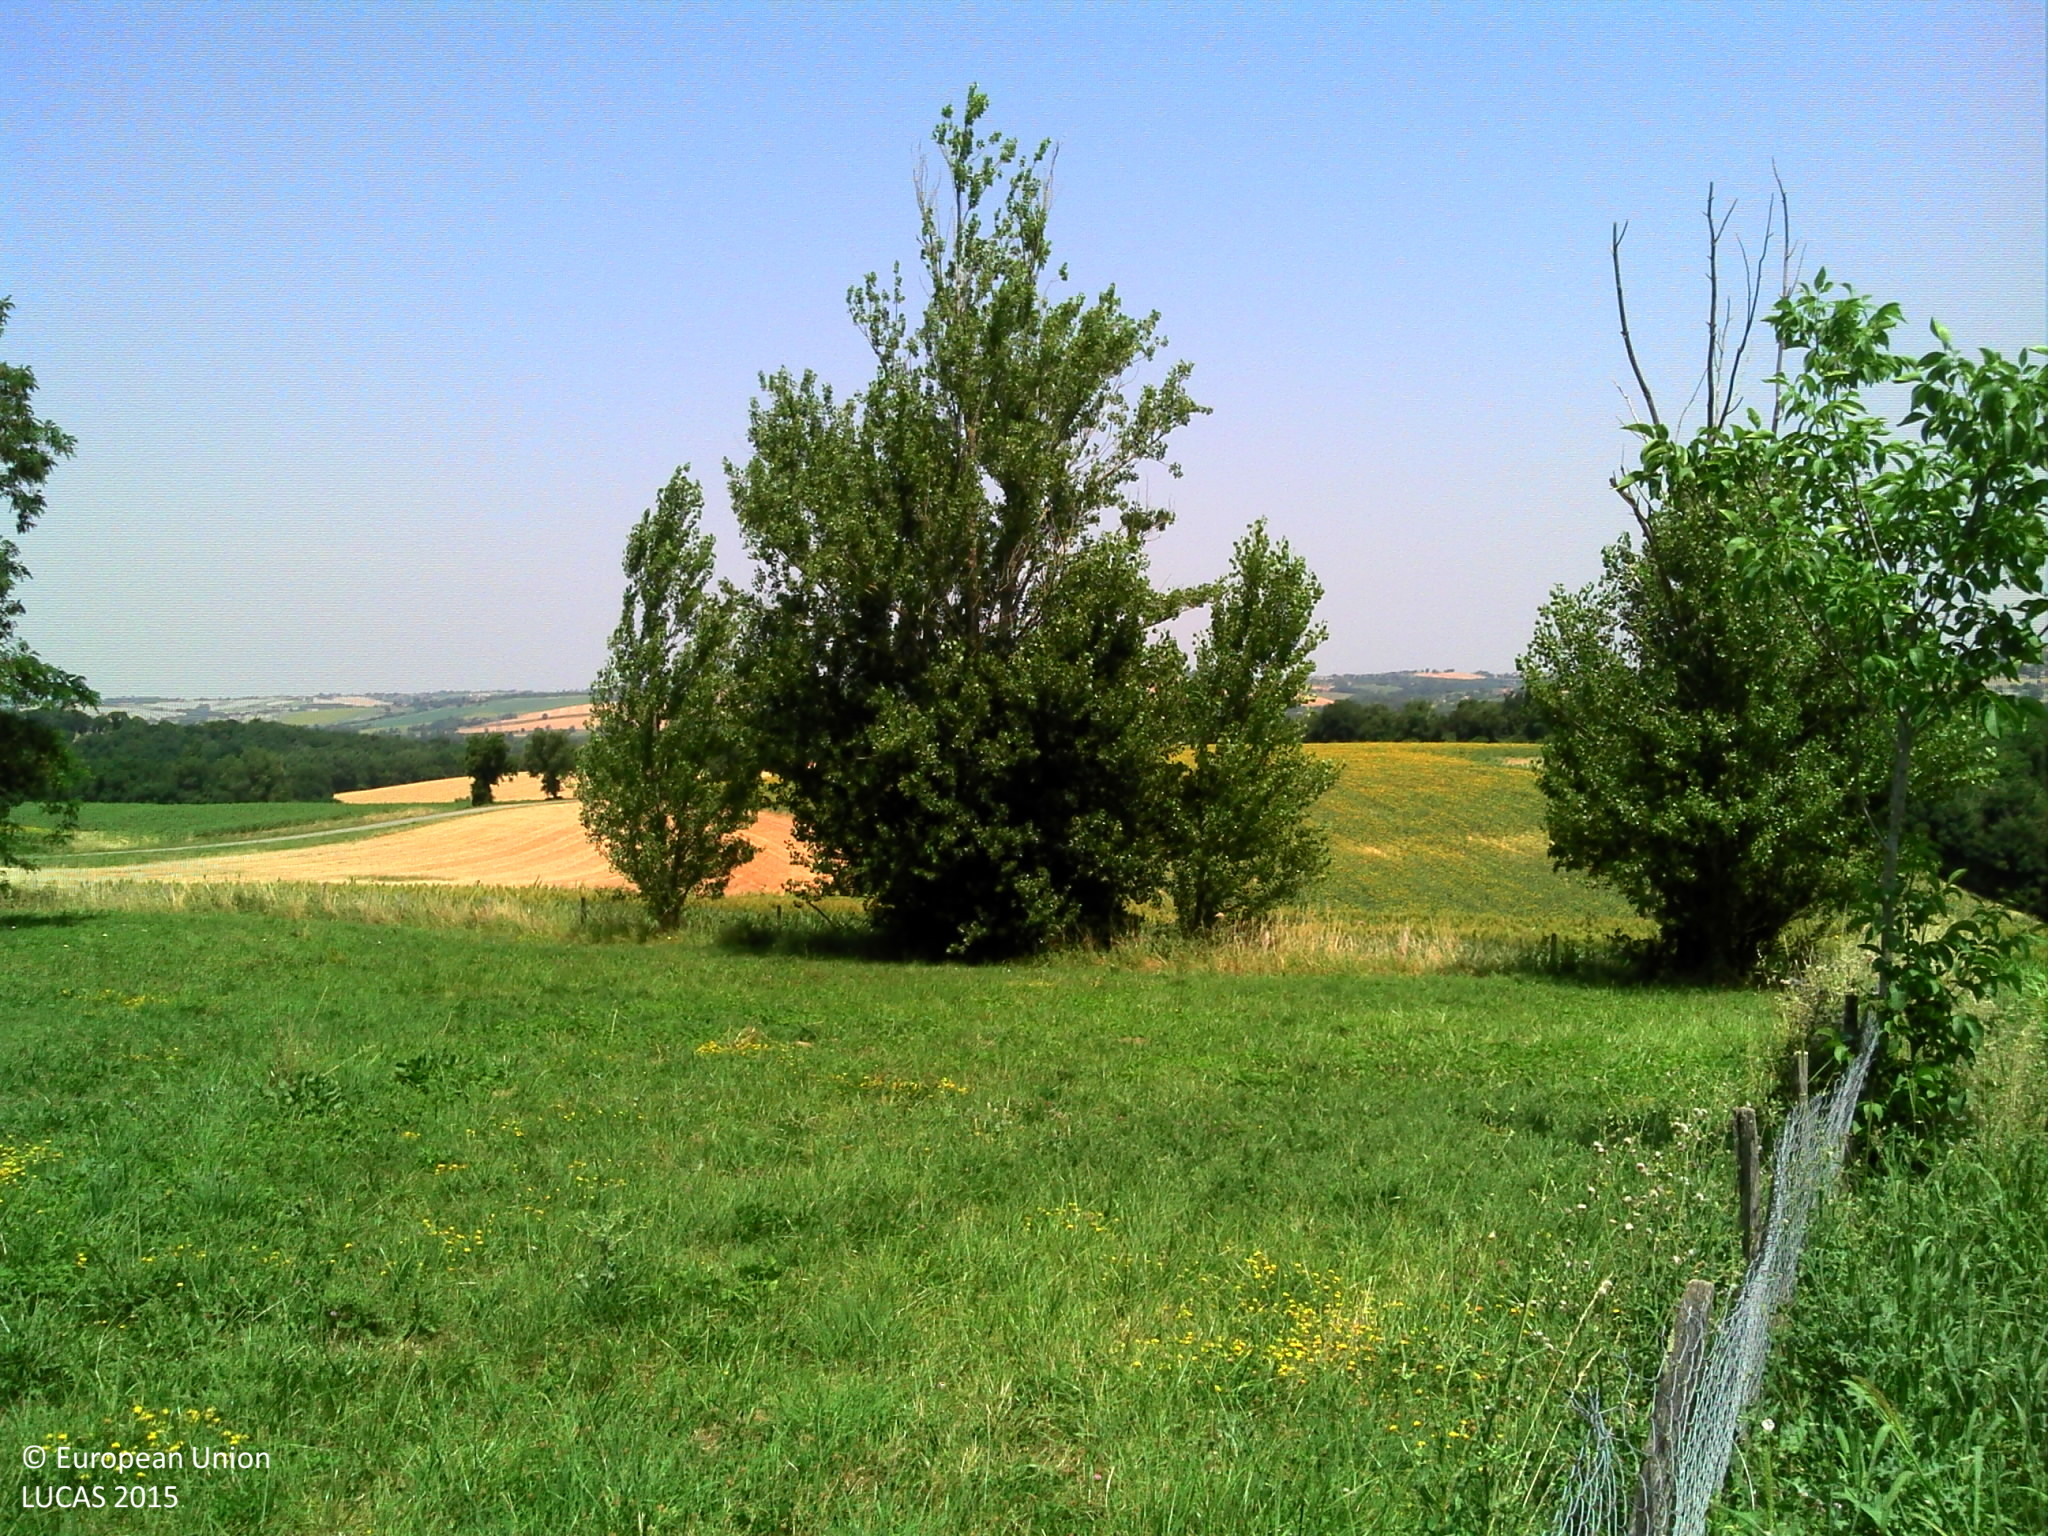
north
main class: Grassland
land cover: Grassland without tree/shrub cover
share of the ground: > 75 %
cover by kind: herbaceous plants 100 %
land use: Agriculture (excluding fallow land and kitchen gardens)
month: July
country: FR
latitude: 43.6318
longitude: 1.6370
